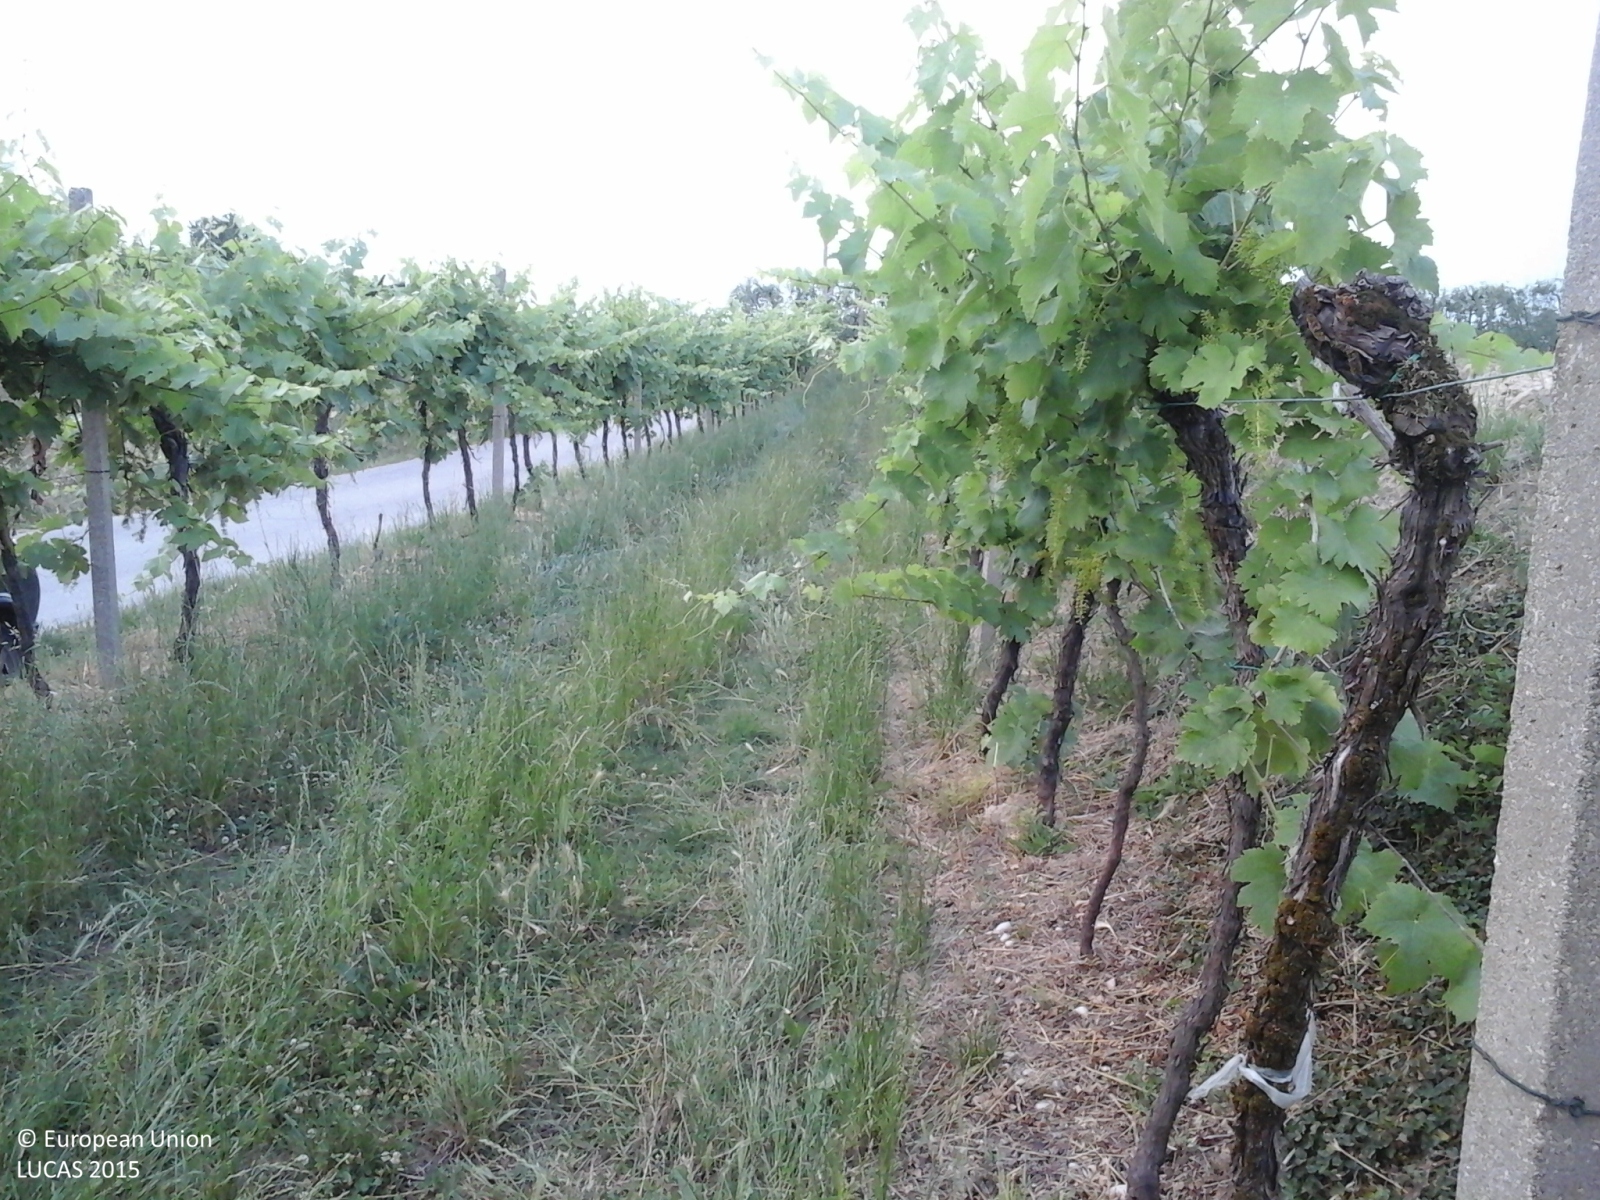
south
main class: Cropland
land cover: Vineyards
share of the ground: 25 - 50 %
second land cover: Grassland without tree/shrub cover
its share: > 75 %
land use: Agriculture (excluding fallow land and kitchen gardens)
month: June
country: IT
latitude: 45.4477
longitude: 10.7531
